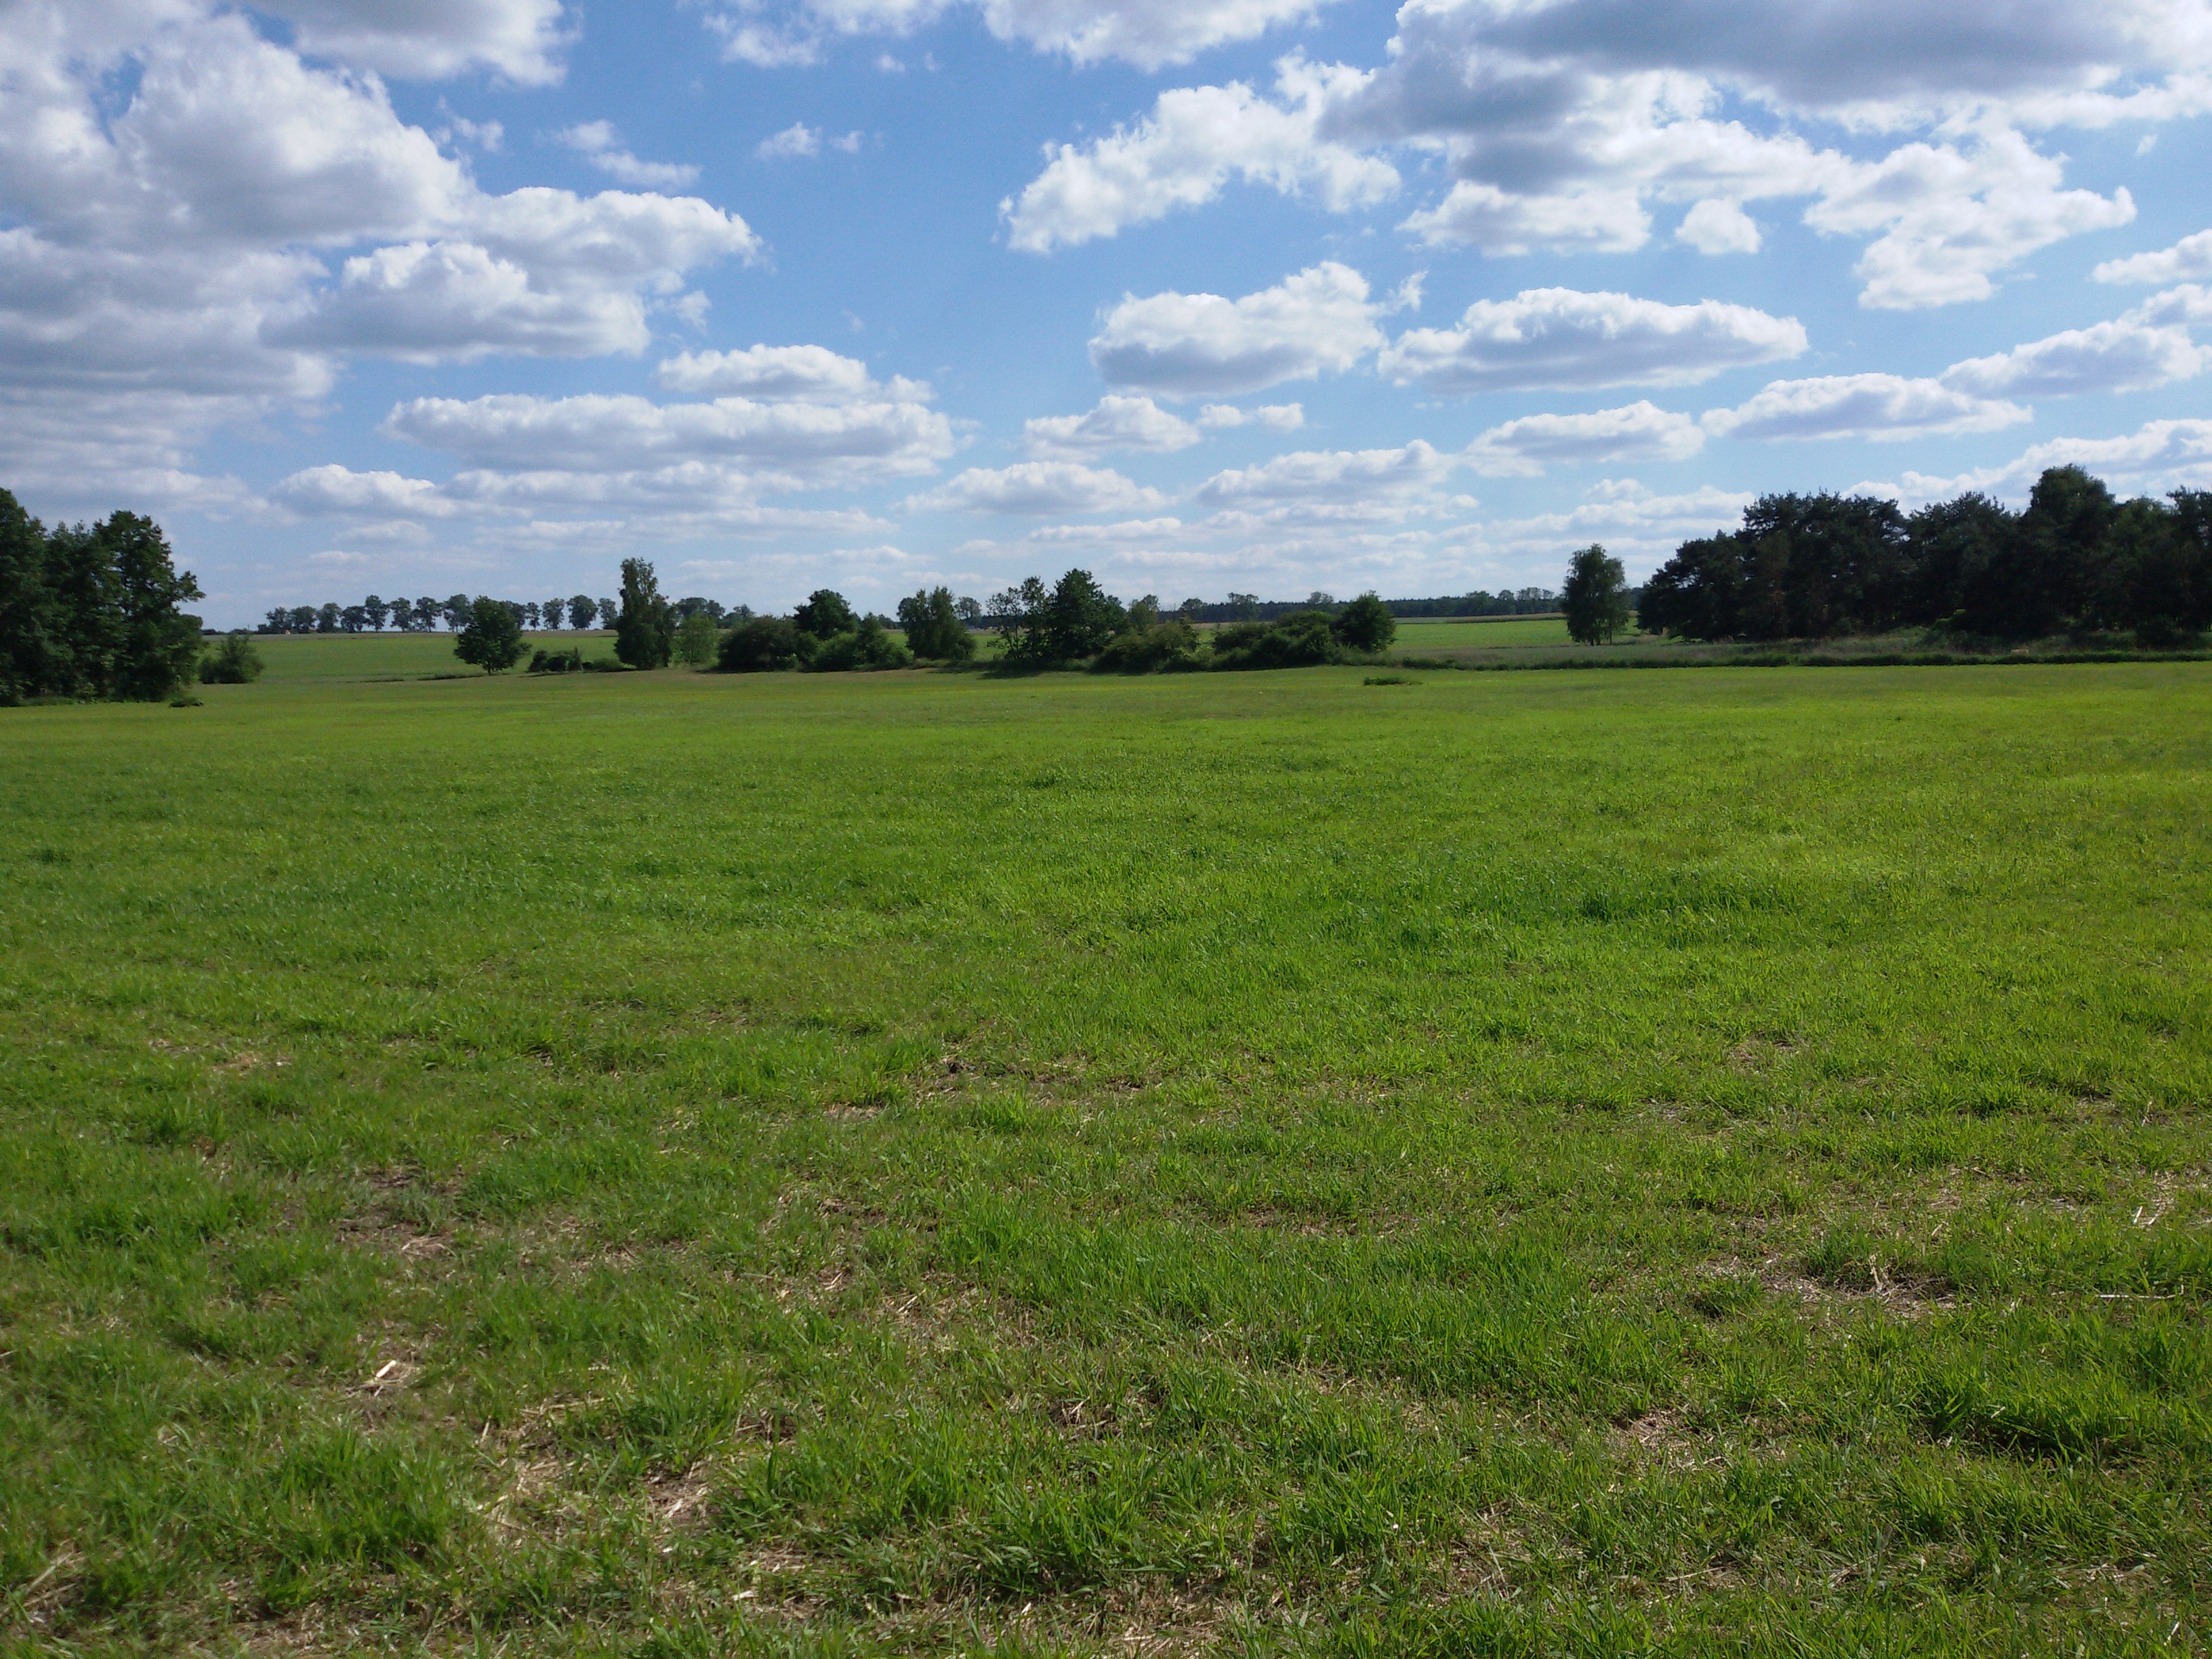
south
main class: Grassland
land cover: Grassland without tree/shrub cover
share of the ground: > 75 %
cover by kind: herbaceous plants 100 %
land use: Agriculture (excluding fallow land and kitchen gardens)
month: June
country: PL
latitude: 52.6417
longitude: 16.9702
